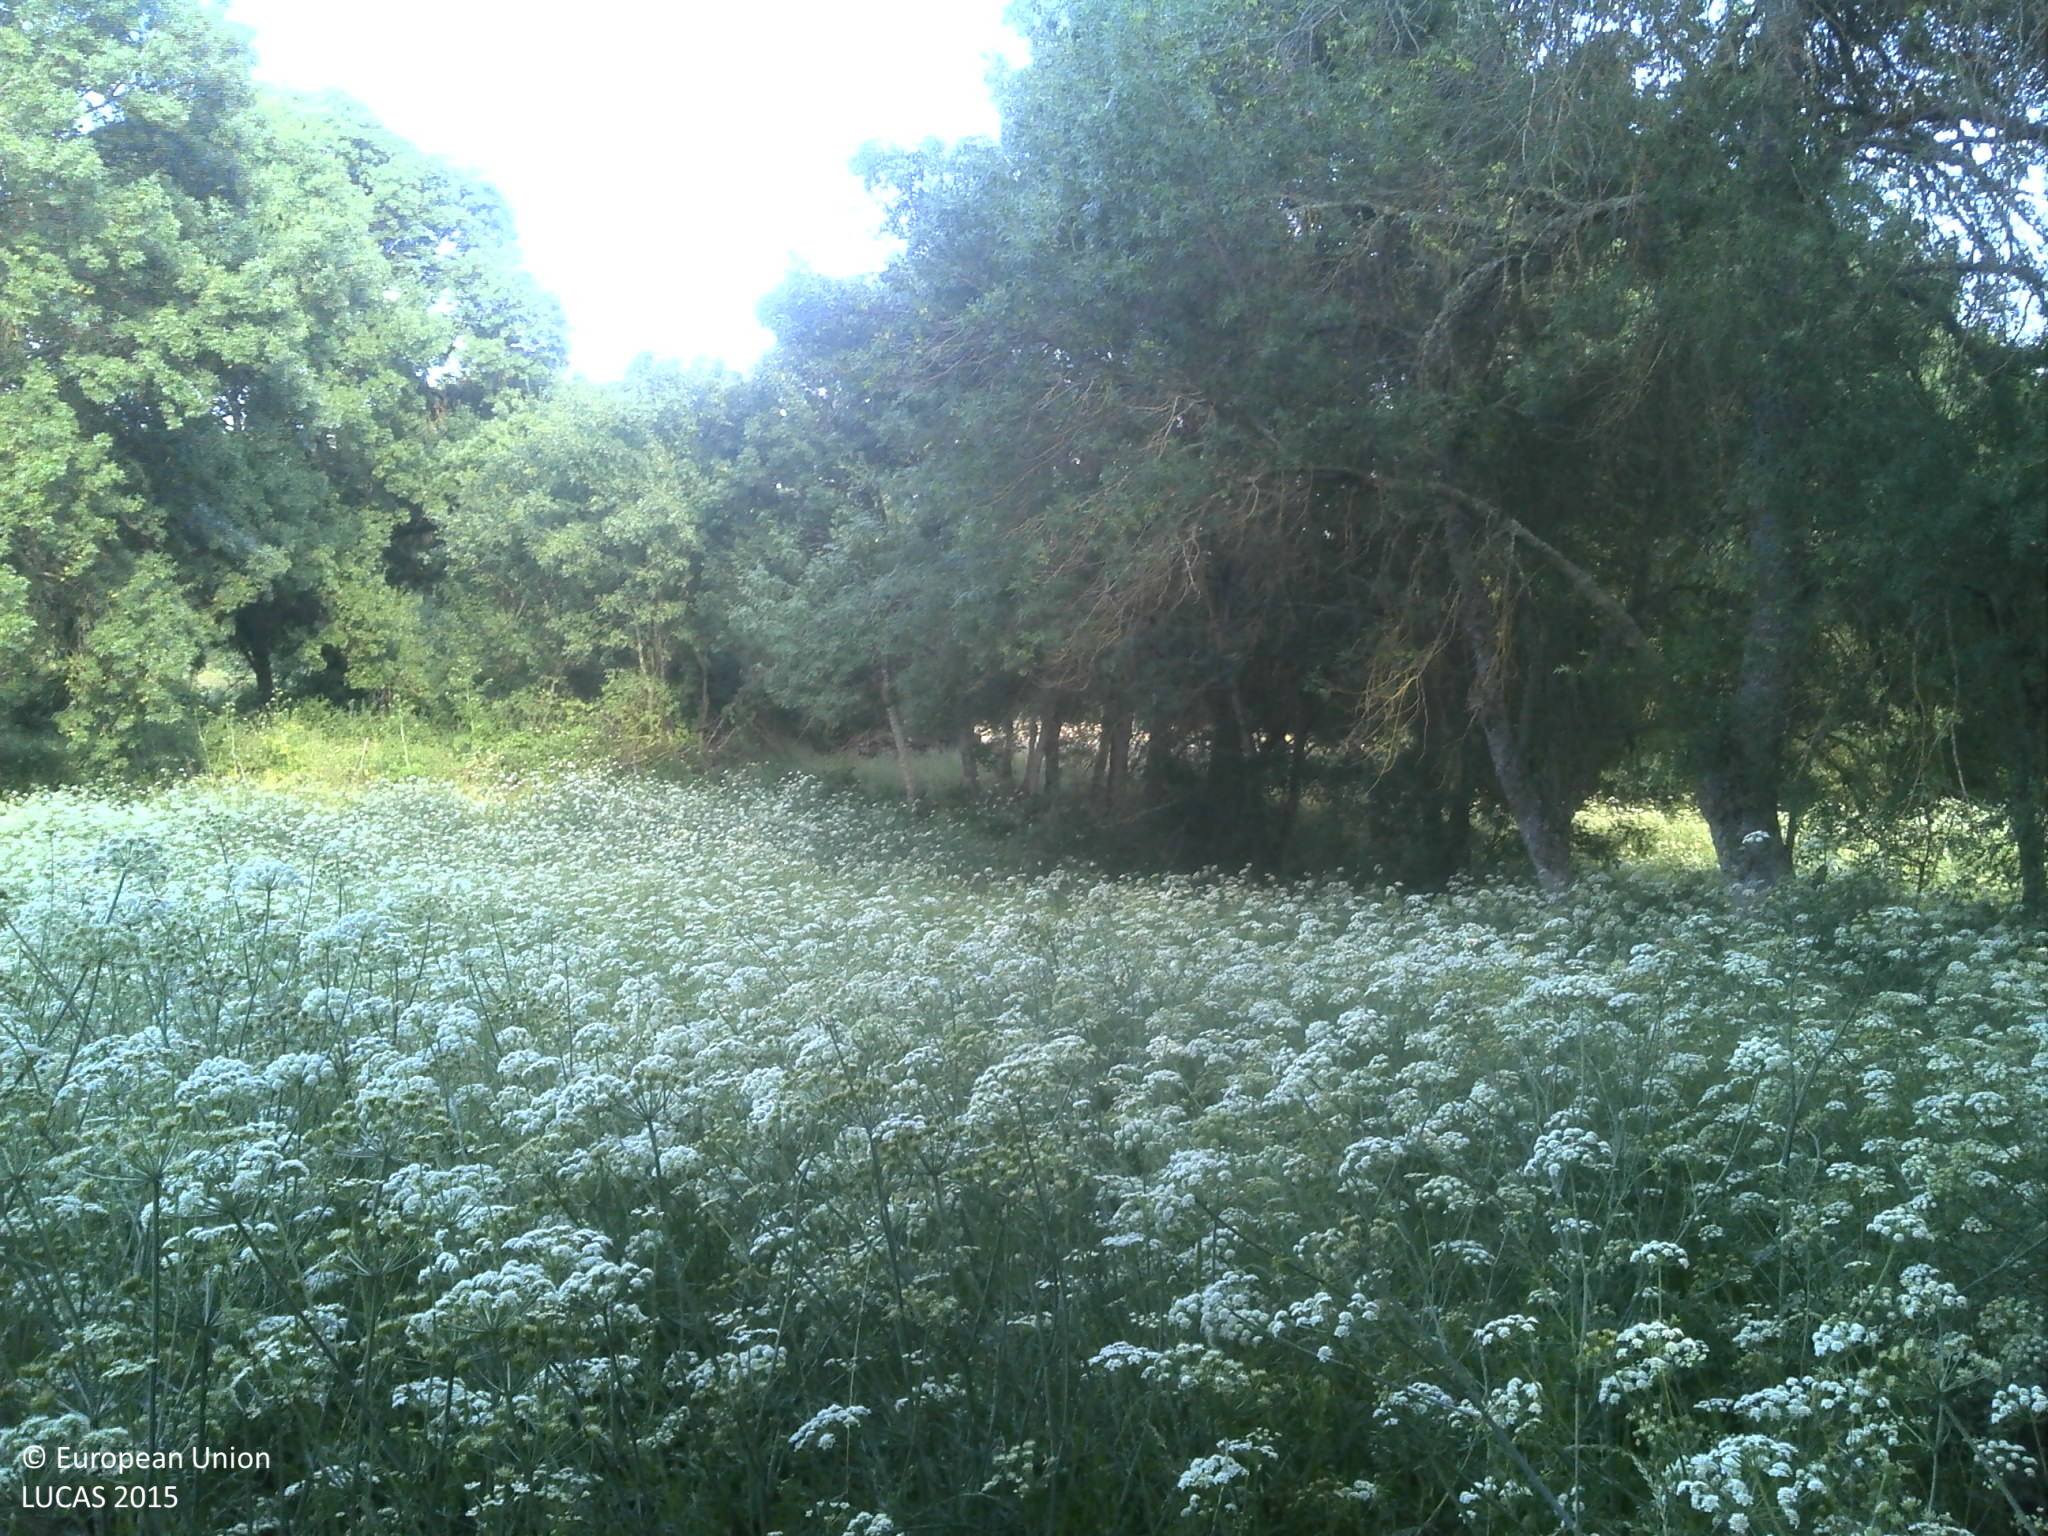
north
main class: Grassland
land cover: Spontaneously vegetated surfaces
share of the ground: 50 - 75 %
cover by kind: herbaceous plants 80 %, unconsolidated bare surface 20 %
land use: Fallow land
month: June
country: PT
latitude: 40.4650
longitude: -7.1193
